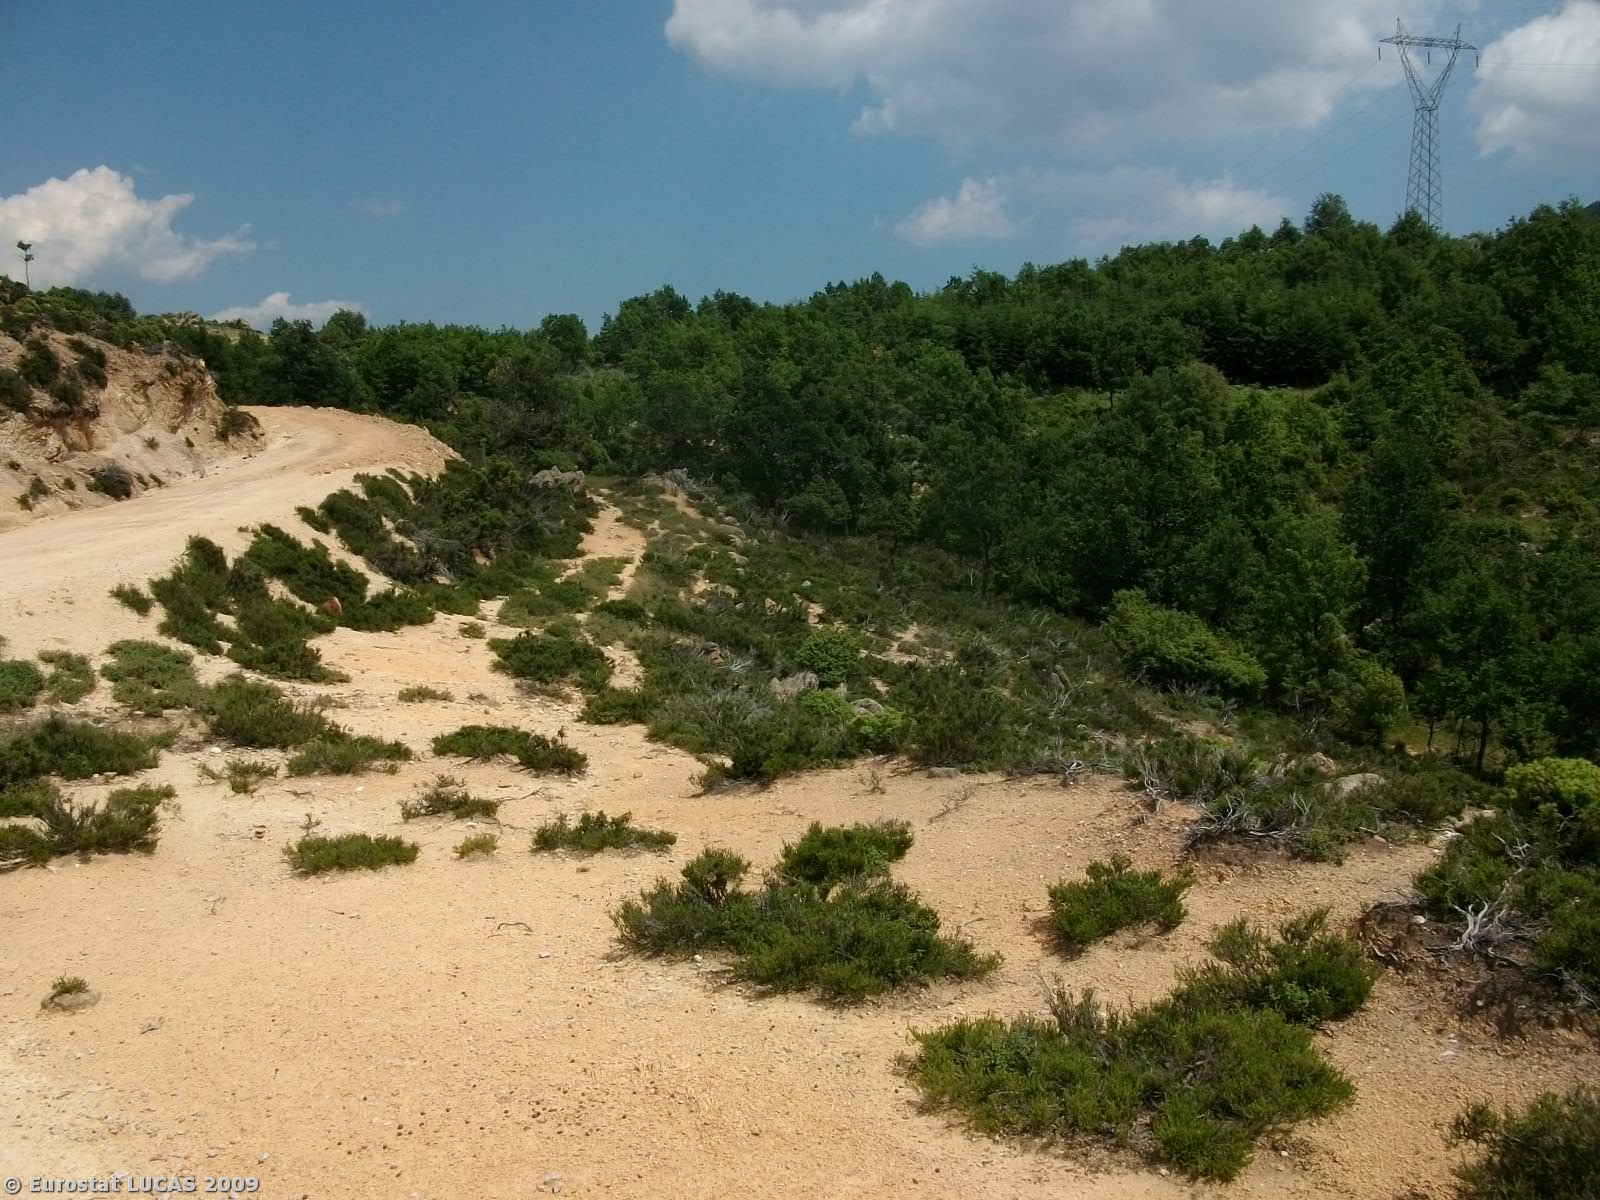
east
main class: Woodland
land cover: Mixed woodland
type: coniferous forest of the mediterranean region
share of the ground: > 75 %
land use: Nature reserves
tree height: > 5 m
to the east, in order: Mixed woodland; Shrubland with sparse tree cover; Electric lines; Mixed woodland; Tracks; Mixed woodland; Shrubland with sparse tree cover
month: July
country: GR
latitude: 40.4805
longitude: 23.5192
